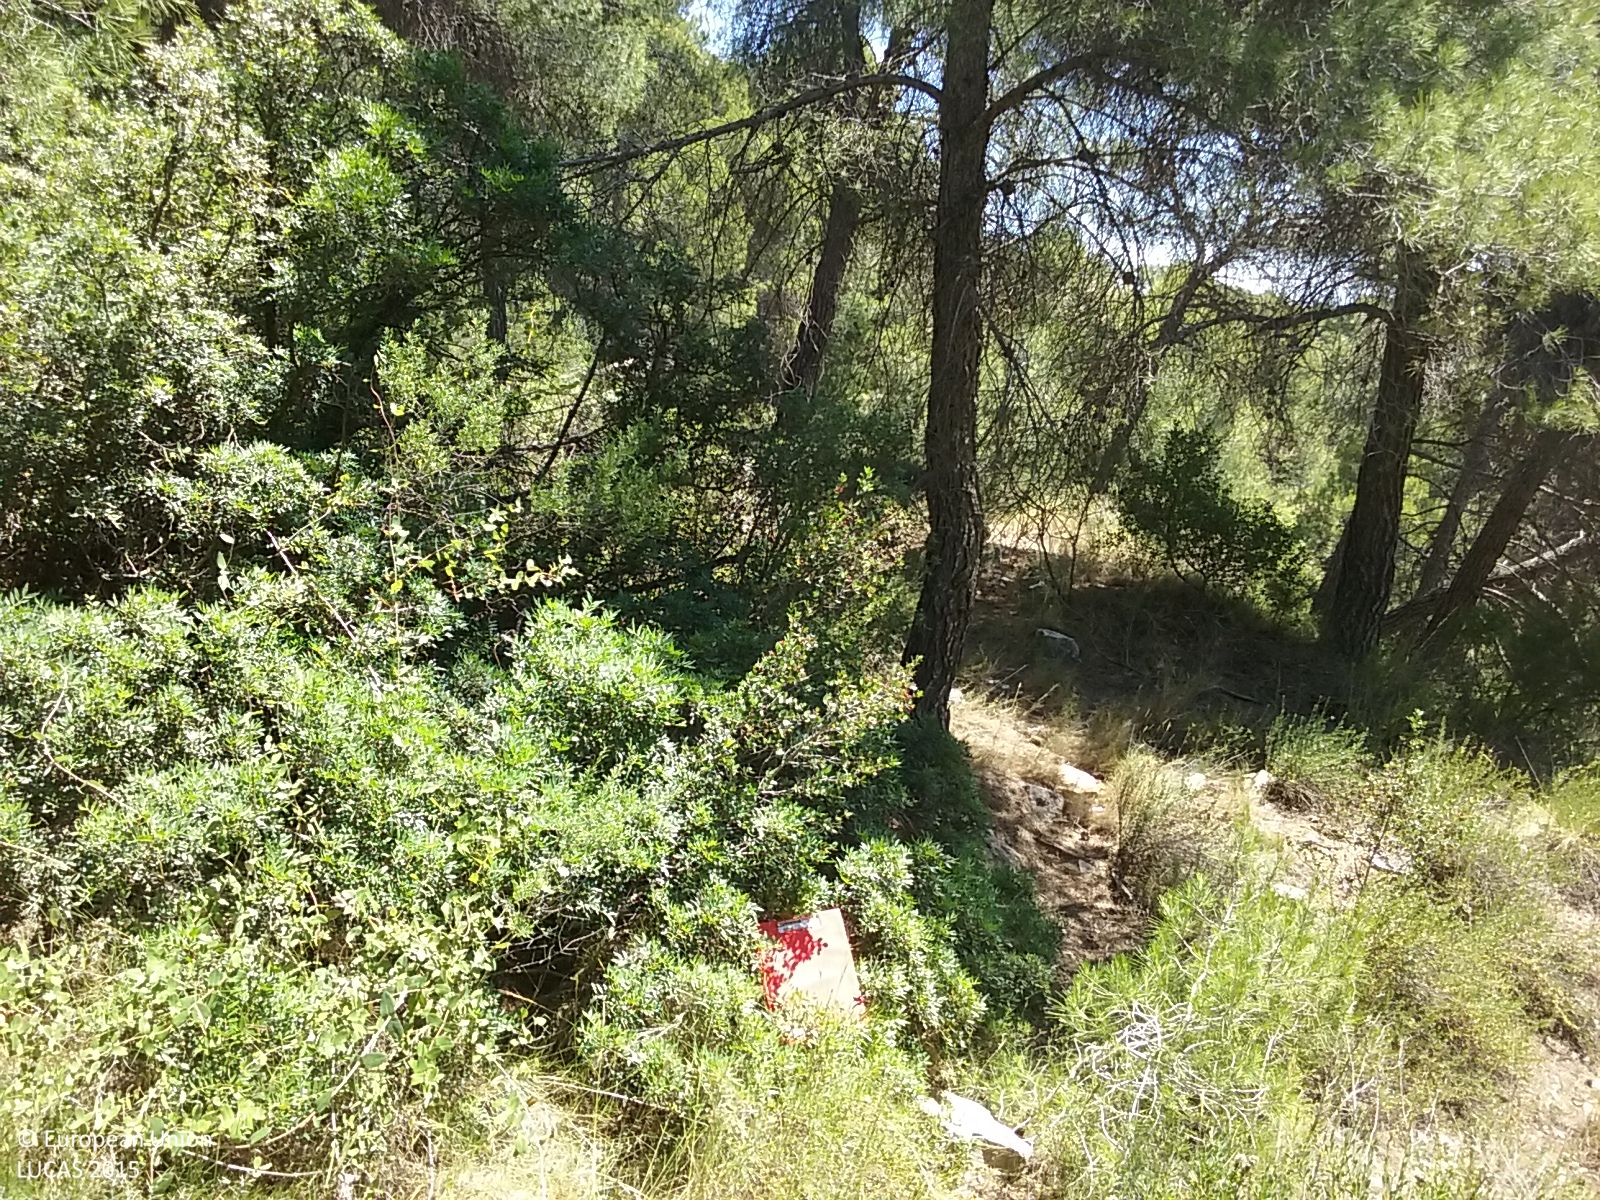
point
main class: Woodland
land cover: Pine dominated coniferous woodland
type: coniferous forest of the mediterranean region
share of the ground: > 75 %
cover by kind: coniferous forest trees 80 %, shrubs 10 %, herbaceous plants 10 %
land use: Semi-natural and natural areas not in use
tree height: > 5 m
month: June
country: ES
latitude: 41.0505
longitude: 0.3899
